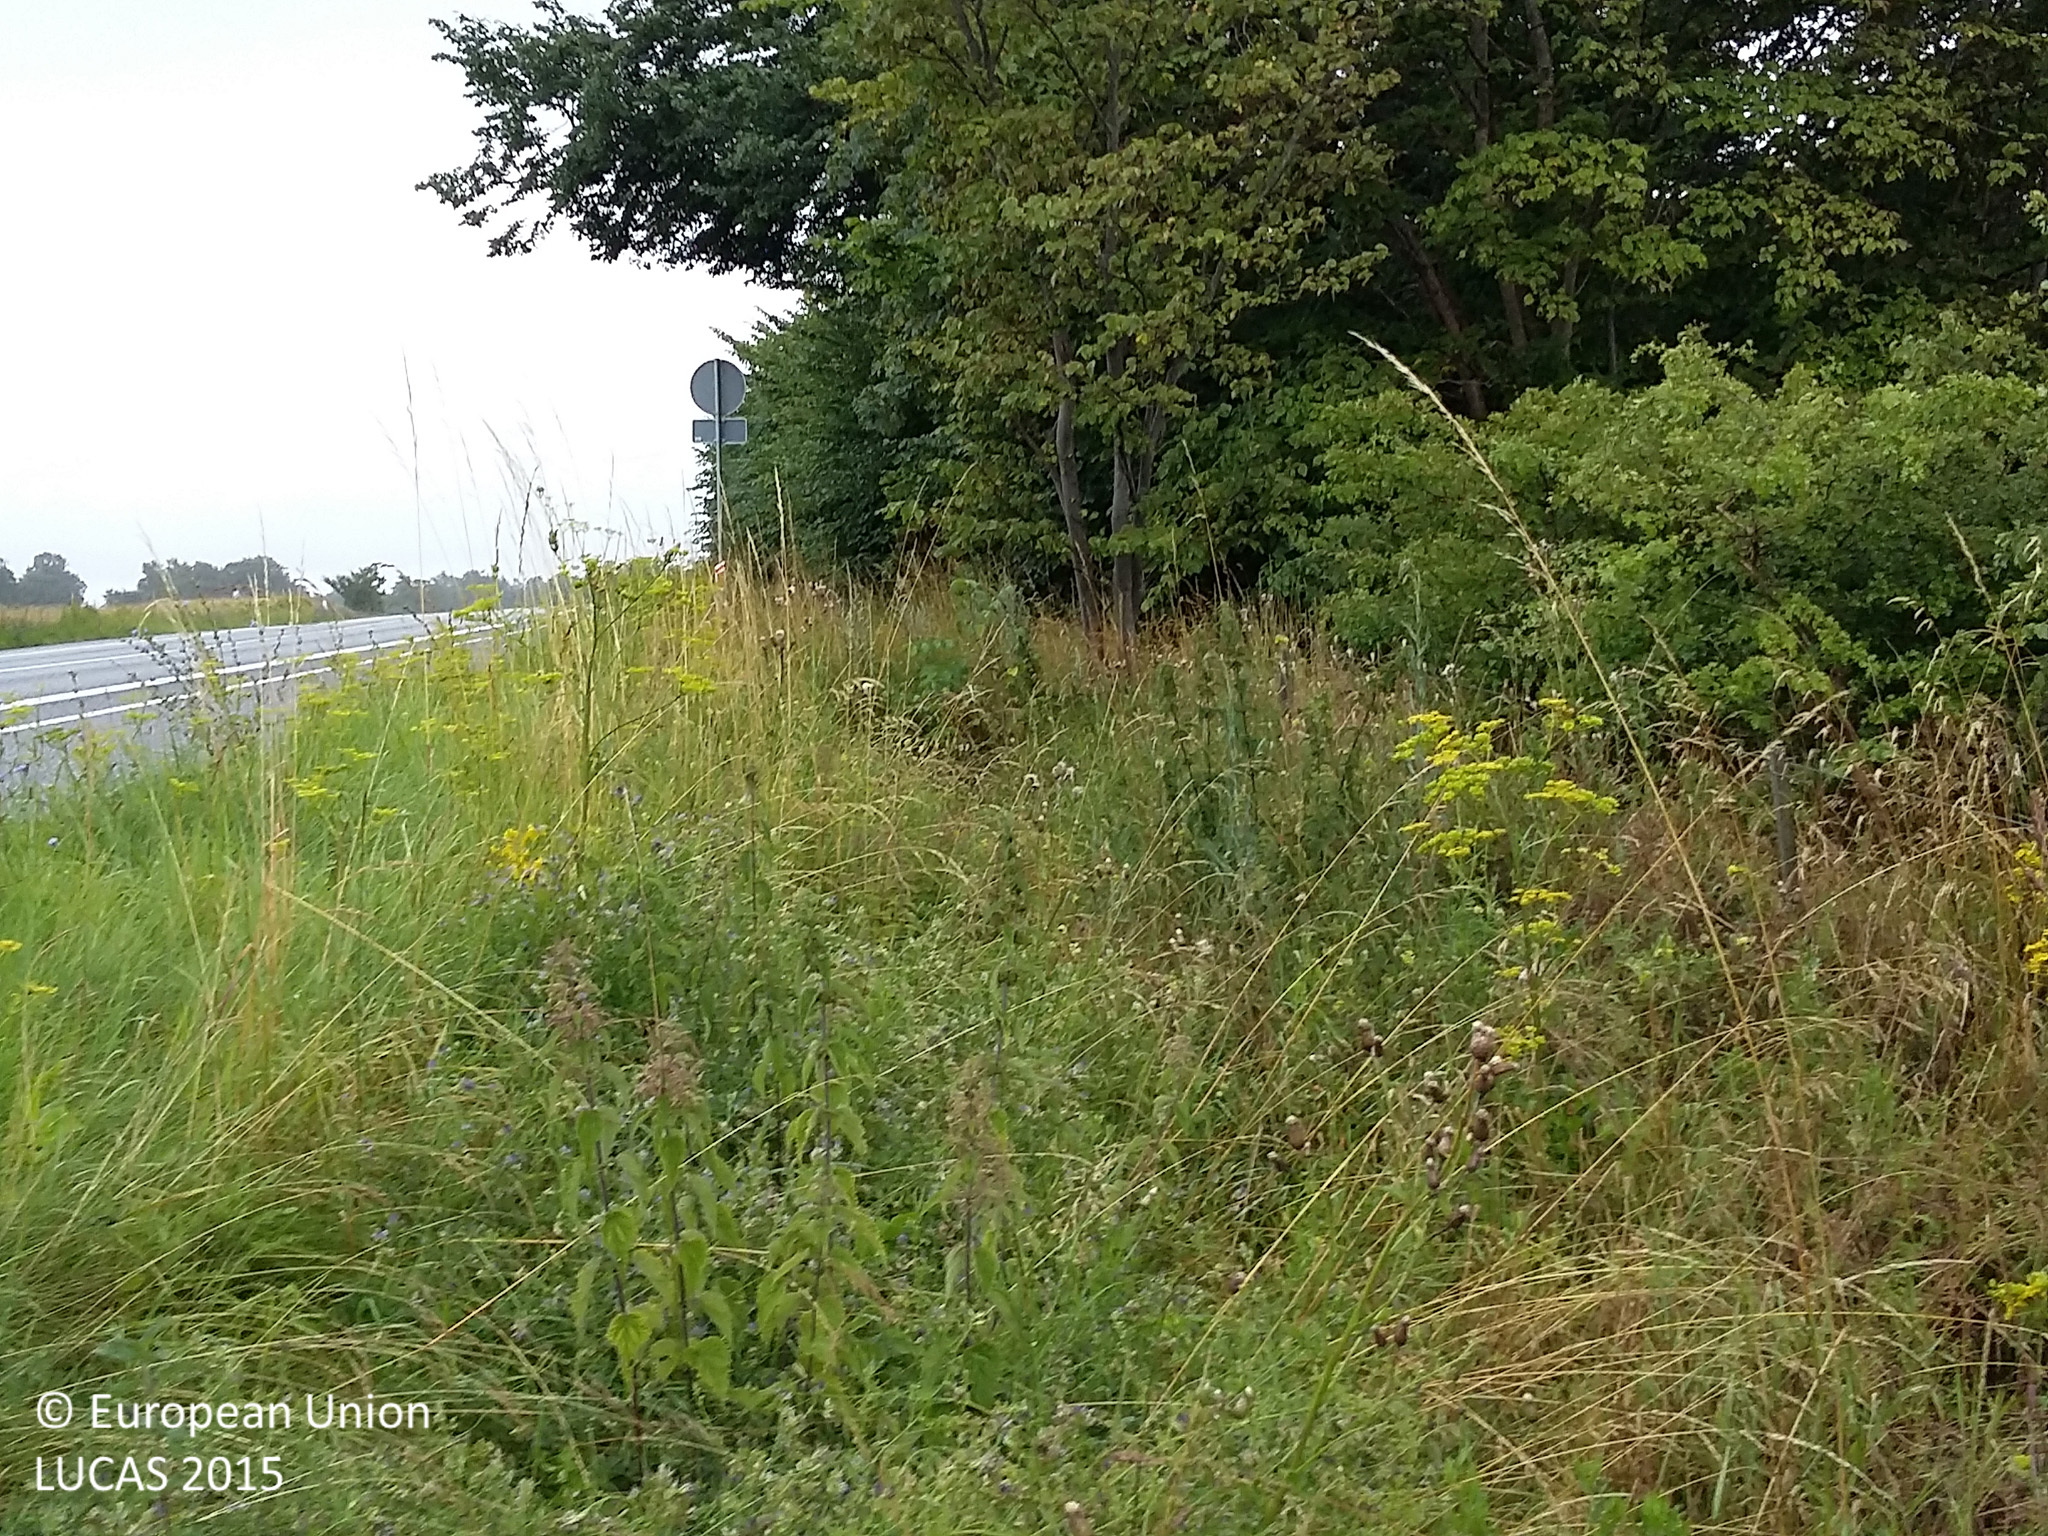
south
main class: Grassland
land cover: Spontaneously vegetated surfaces
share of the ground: > 75 %
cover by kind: herbaceous plants 100 %
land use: Semi-natural and natural areas not in use
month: July
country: DK
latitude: 55.9015
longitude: 12.0613
